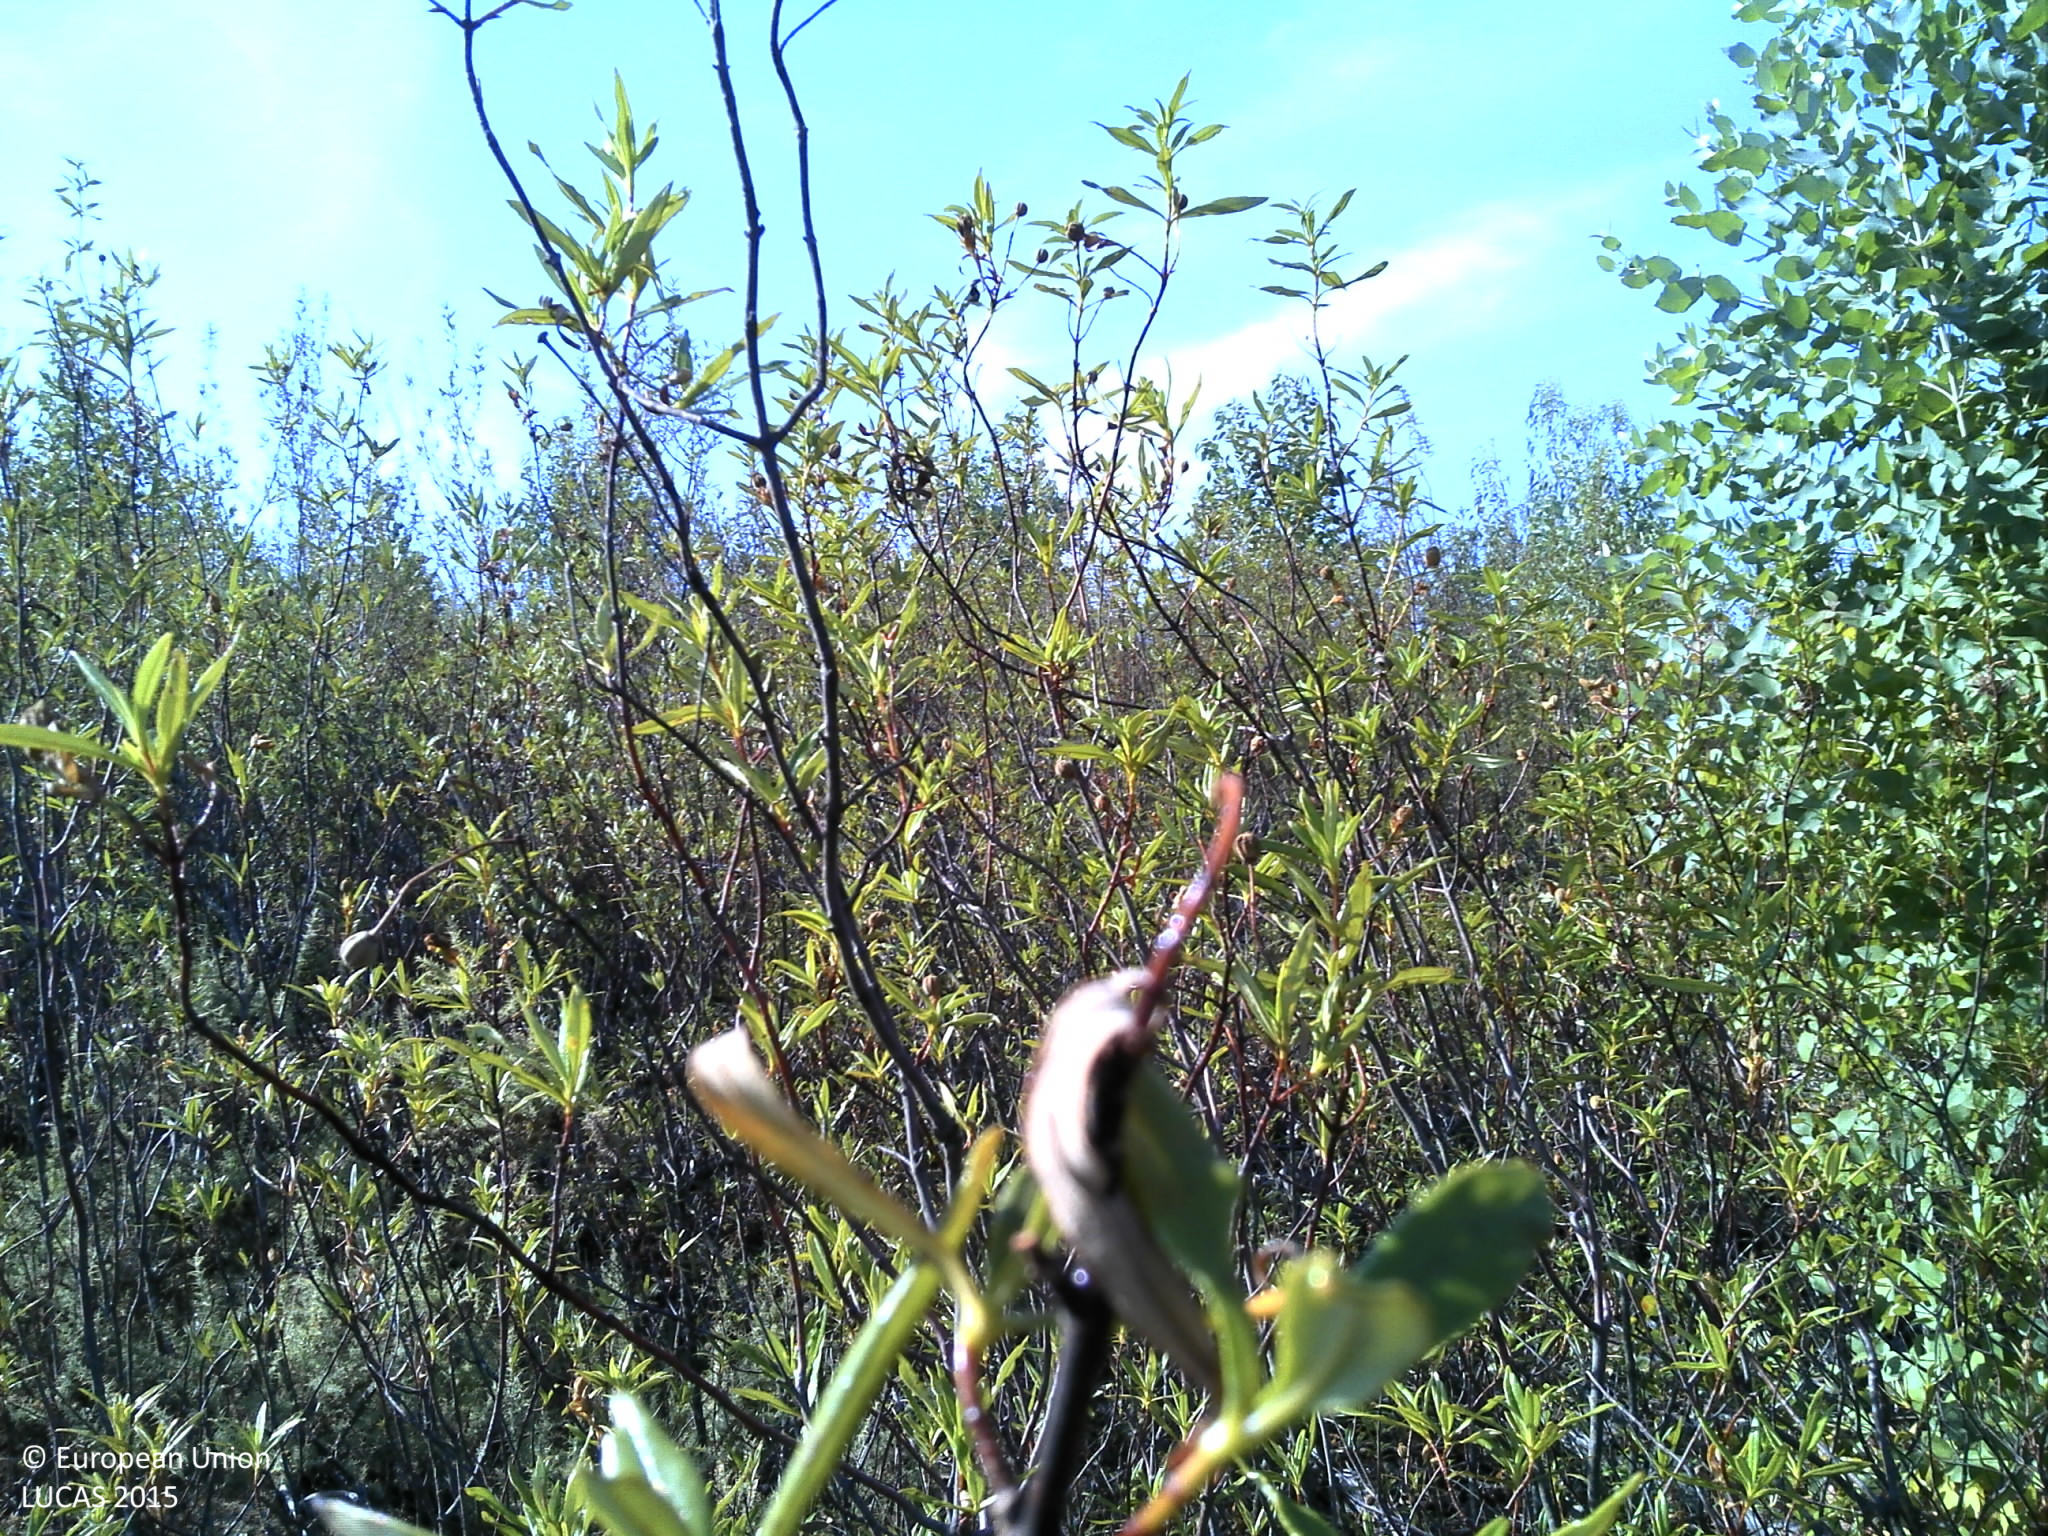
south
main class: Woodland
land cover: Broadleaved woodland
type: exotic forest
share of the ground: 25 - 50 %
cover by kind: shrubs 40 %, broadleaved forest trees 25 %, herbaceous plants 15 %, consolidated bare surface 10 %, unconsolidated bare surface 10 %
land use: Forestry
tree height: < 5 m
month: July
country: PT
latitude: 38.5979
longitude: -7.4473
